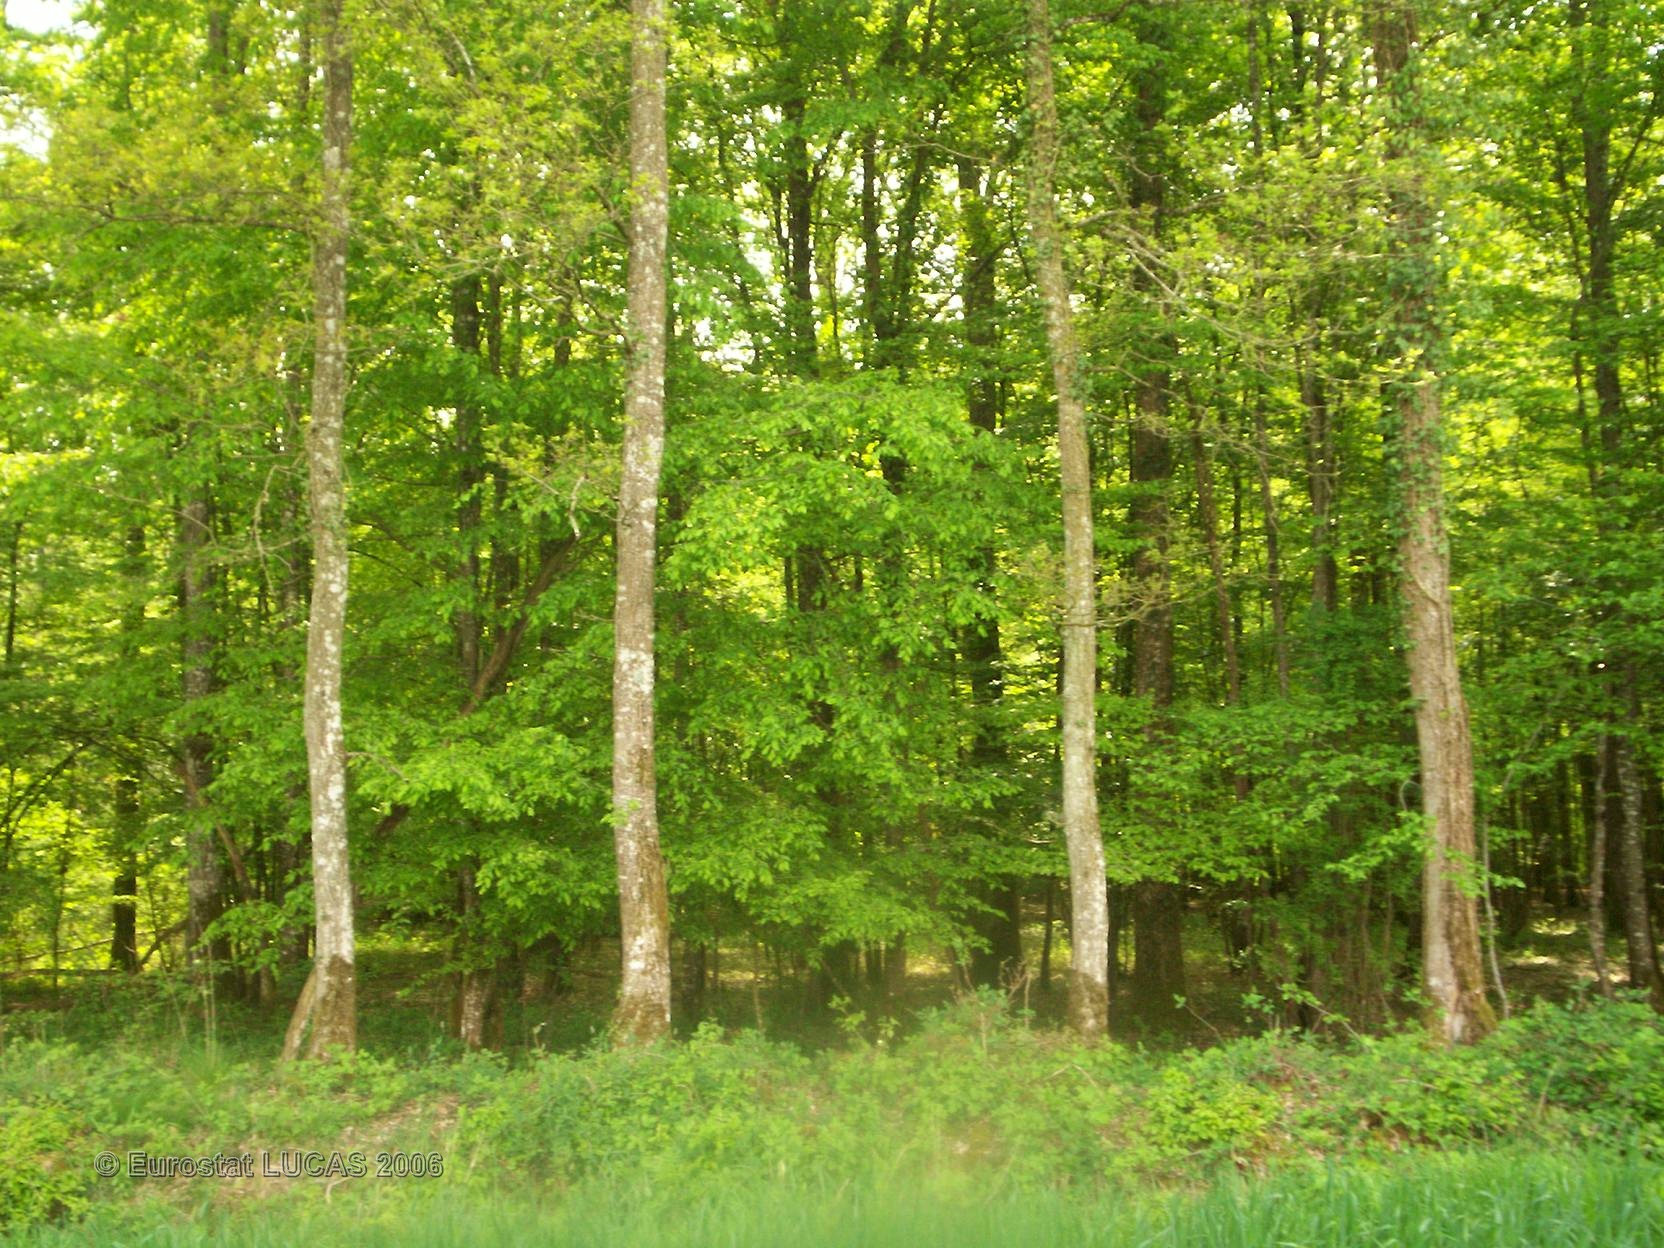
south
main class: Cropland
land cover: Barley
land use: Agriculture (excluding fallow land and kitchen gardens)
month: May
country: FR
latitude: 47.8745
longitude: 3.0006
